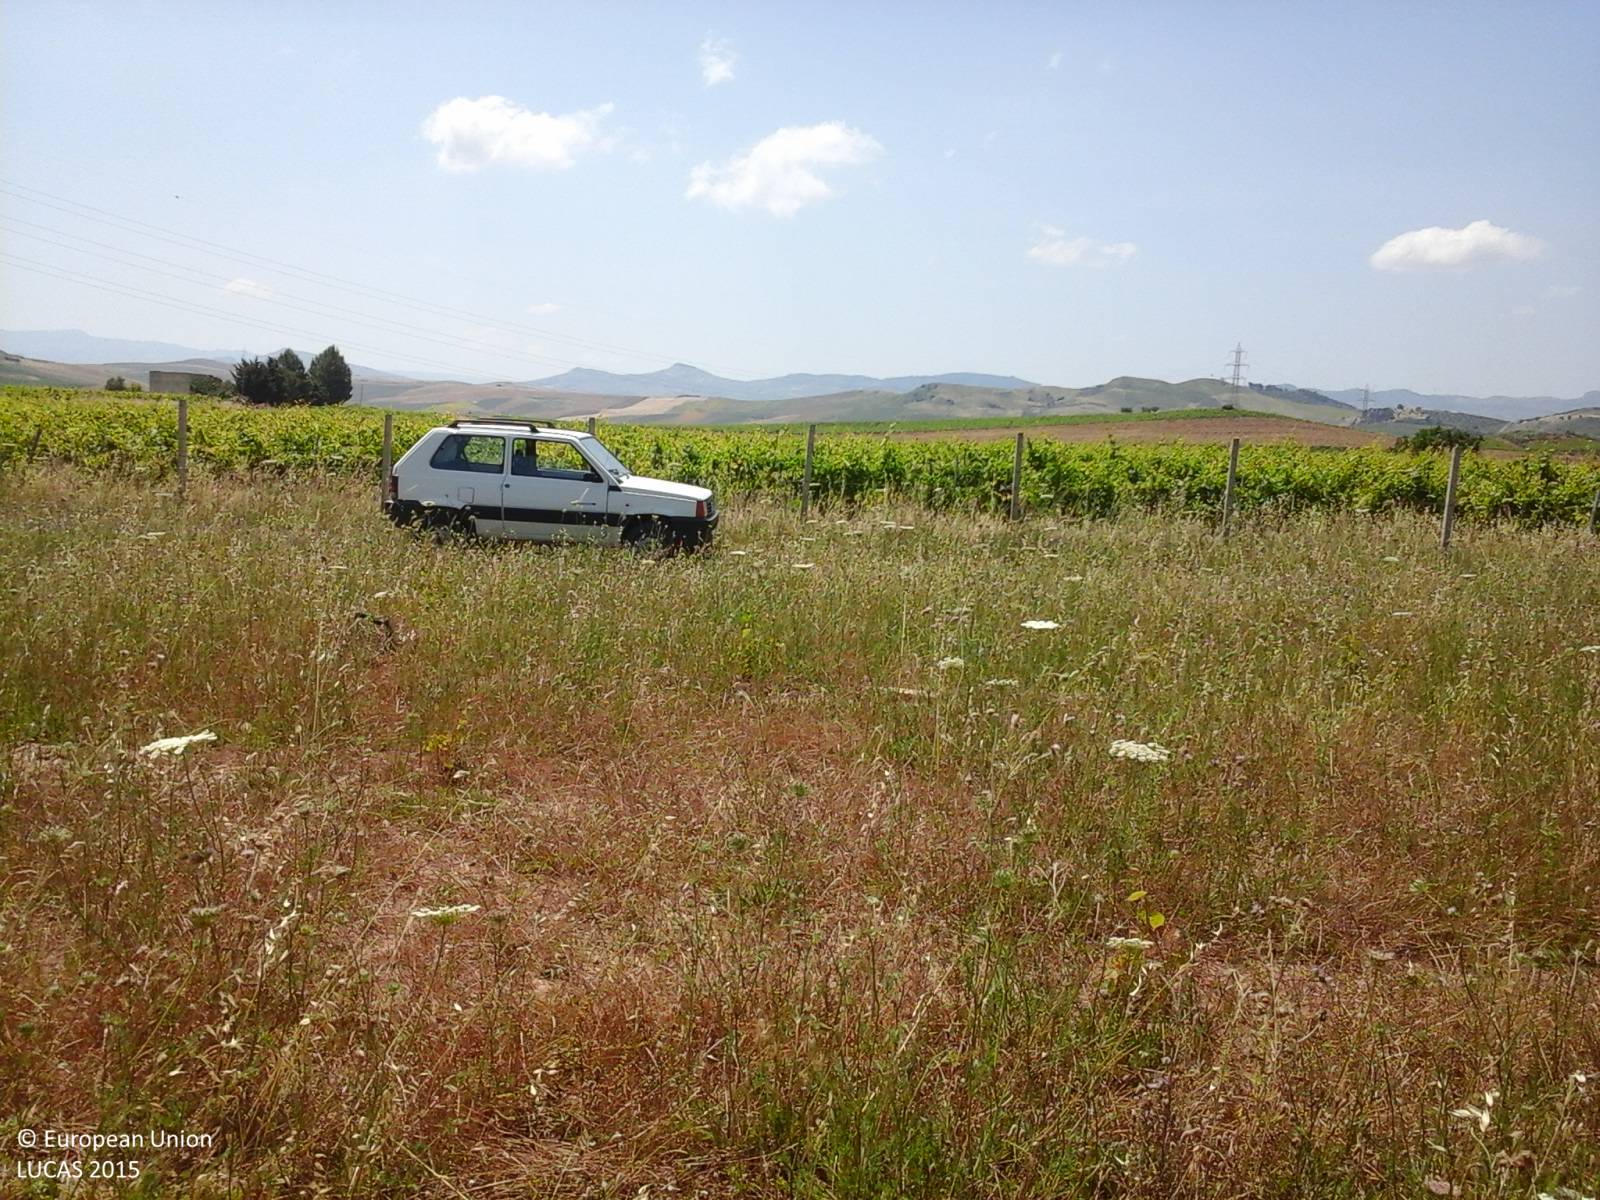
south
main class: Grassland
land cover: Grassland without tree/shrub cover
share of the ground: > 75 %
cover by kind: herbaceous plants 100 %
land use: Abandoned areas
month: June
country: IT
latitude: 37.9184
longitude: 12.9927
